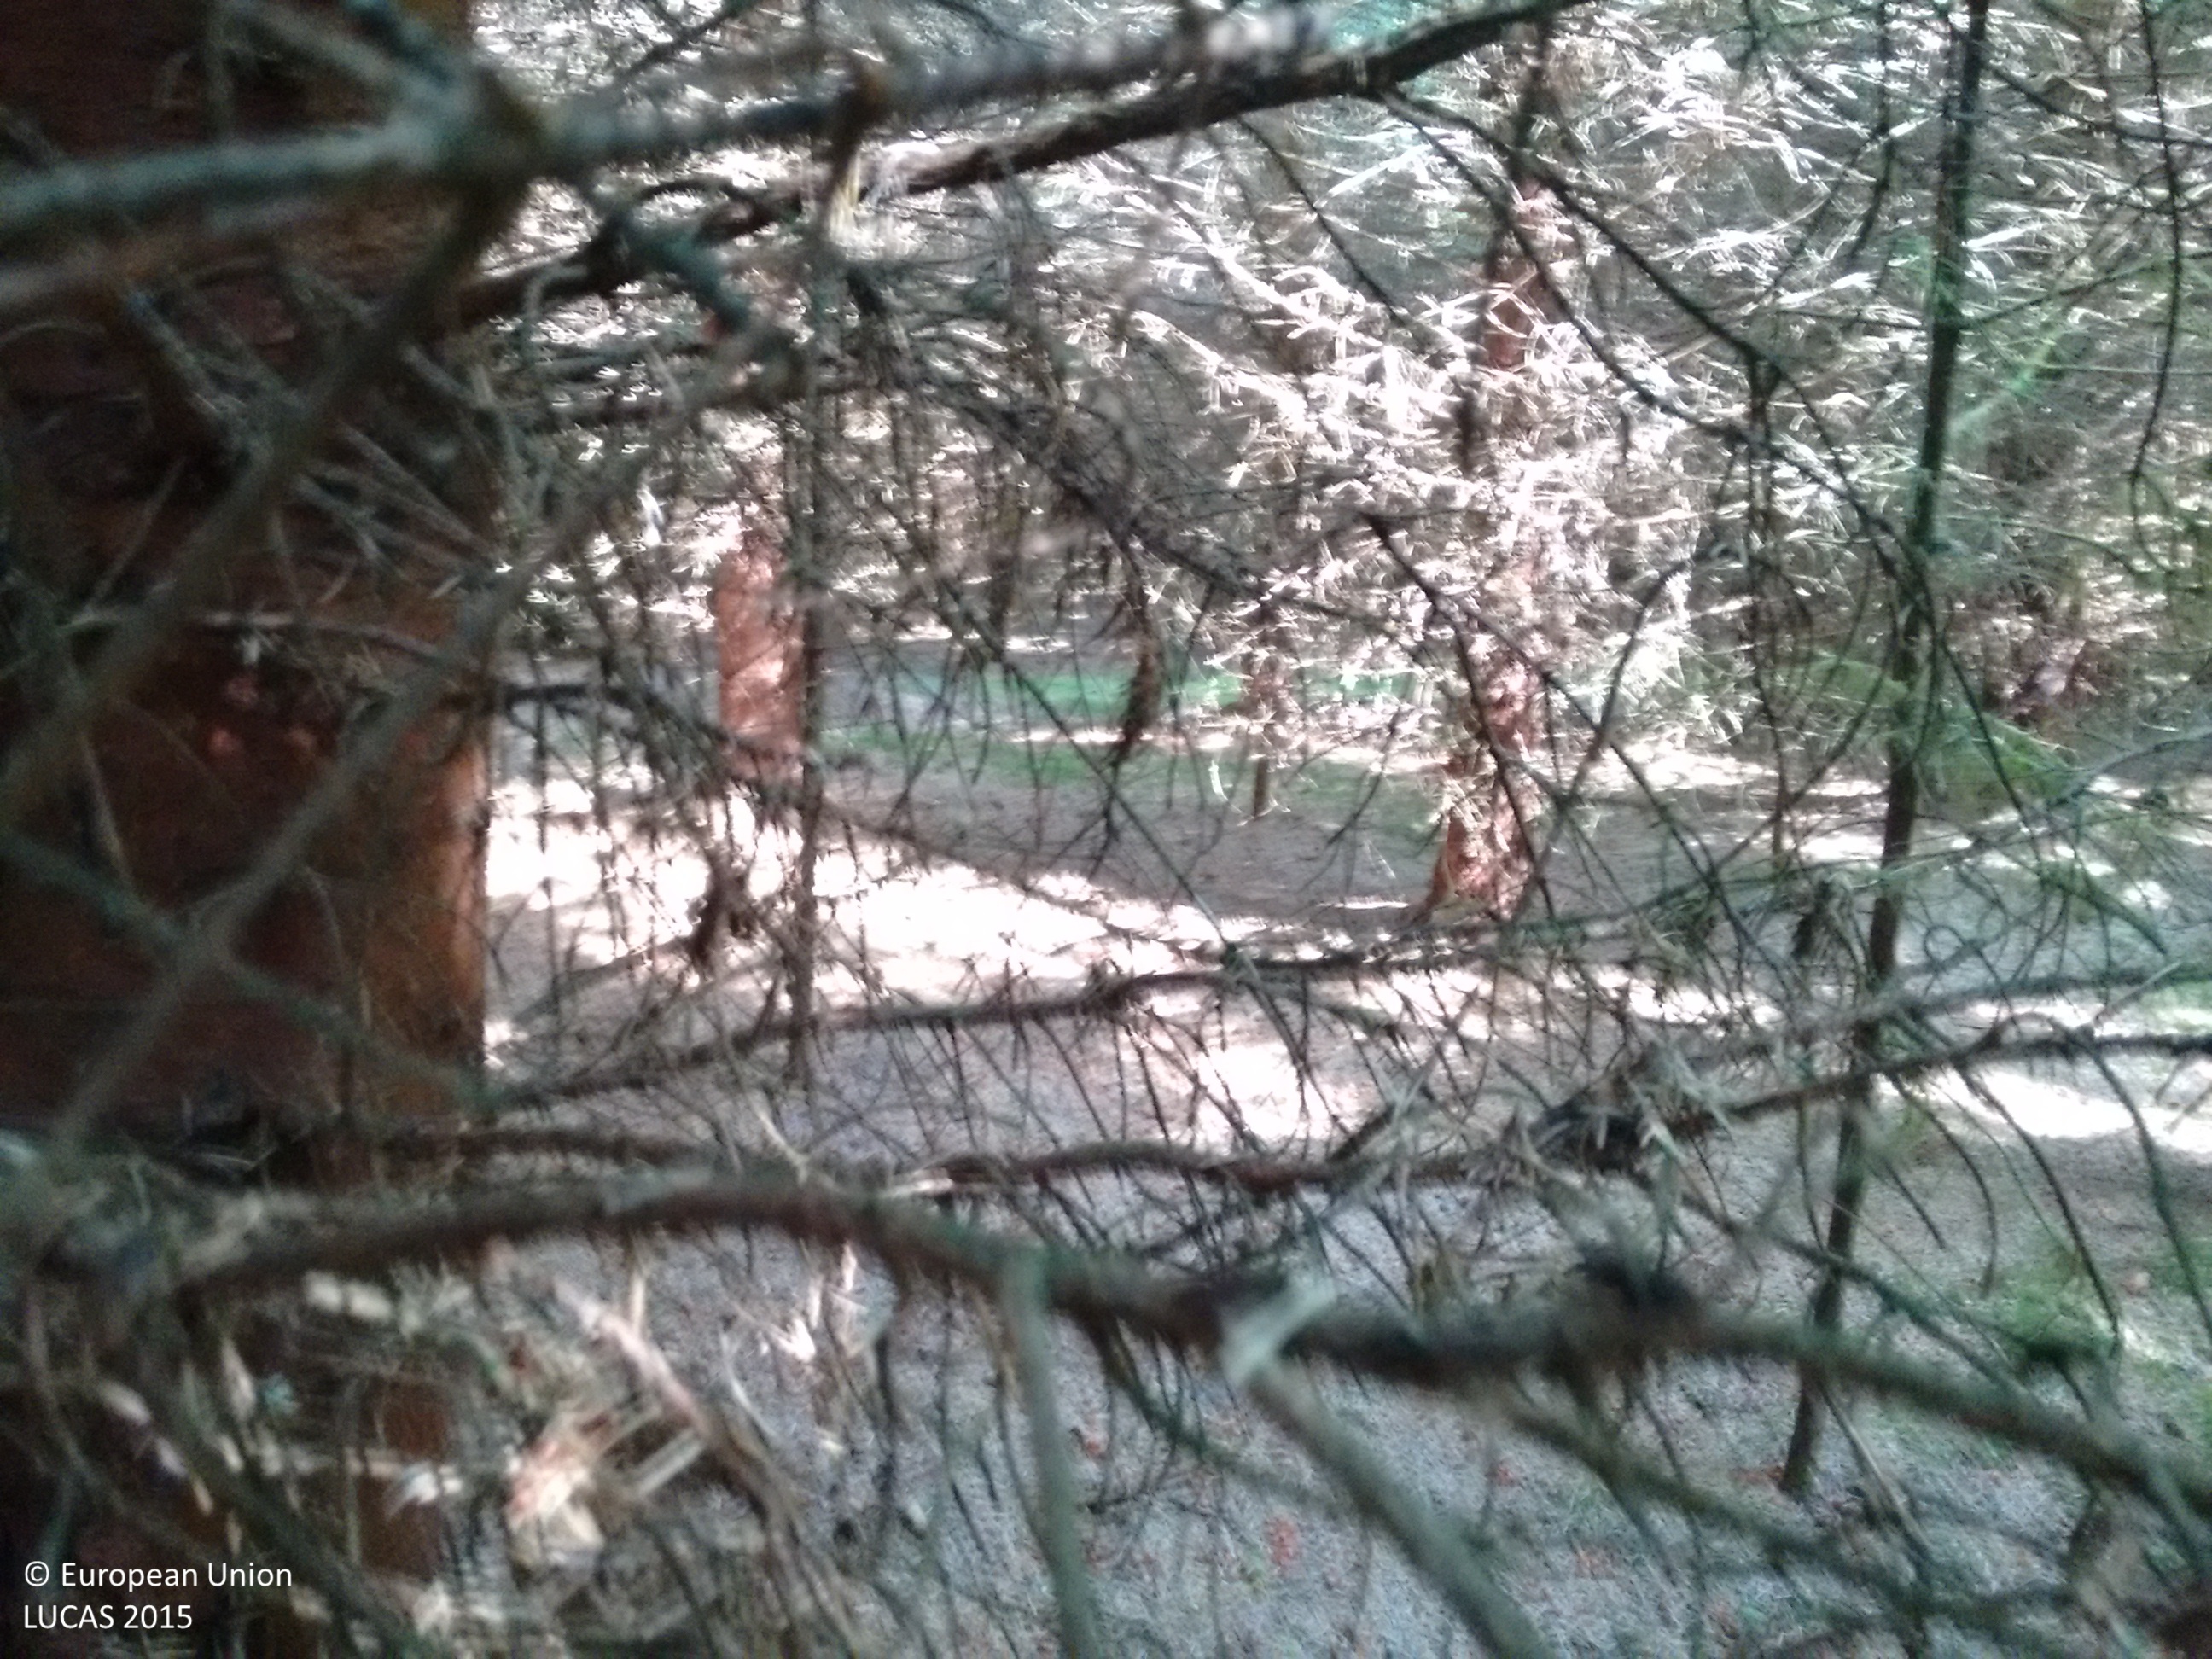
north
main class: Woodland
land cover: Spruce dominated coniferous woodland
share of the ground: > 75 %
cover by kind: coniferous forest trees 80 %, herbaceous plants 10 %, lichens and mosses 10 %
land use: Forestry
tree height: < 5 m
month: July
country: GB
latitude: 55.6070
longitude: -3.7510
